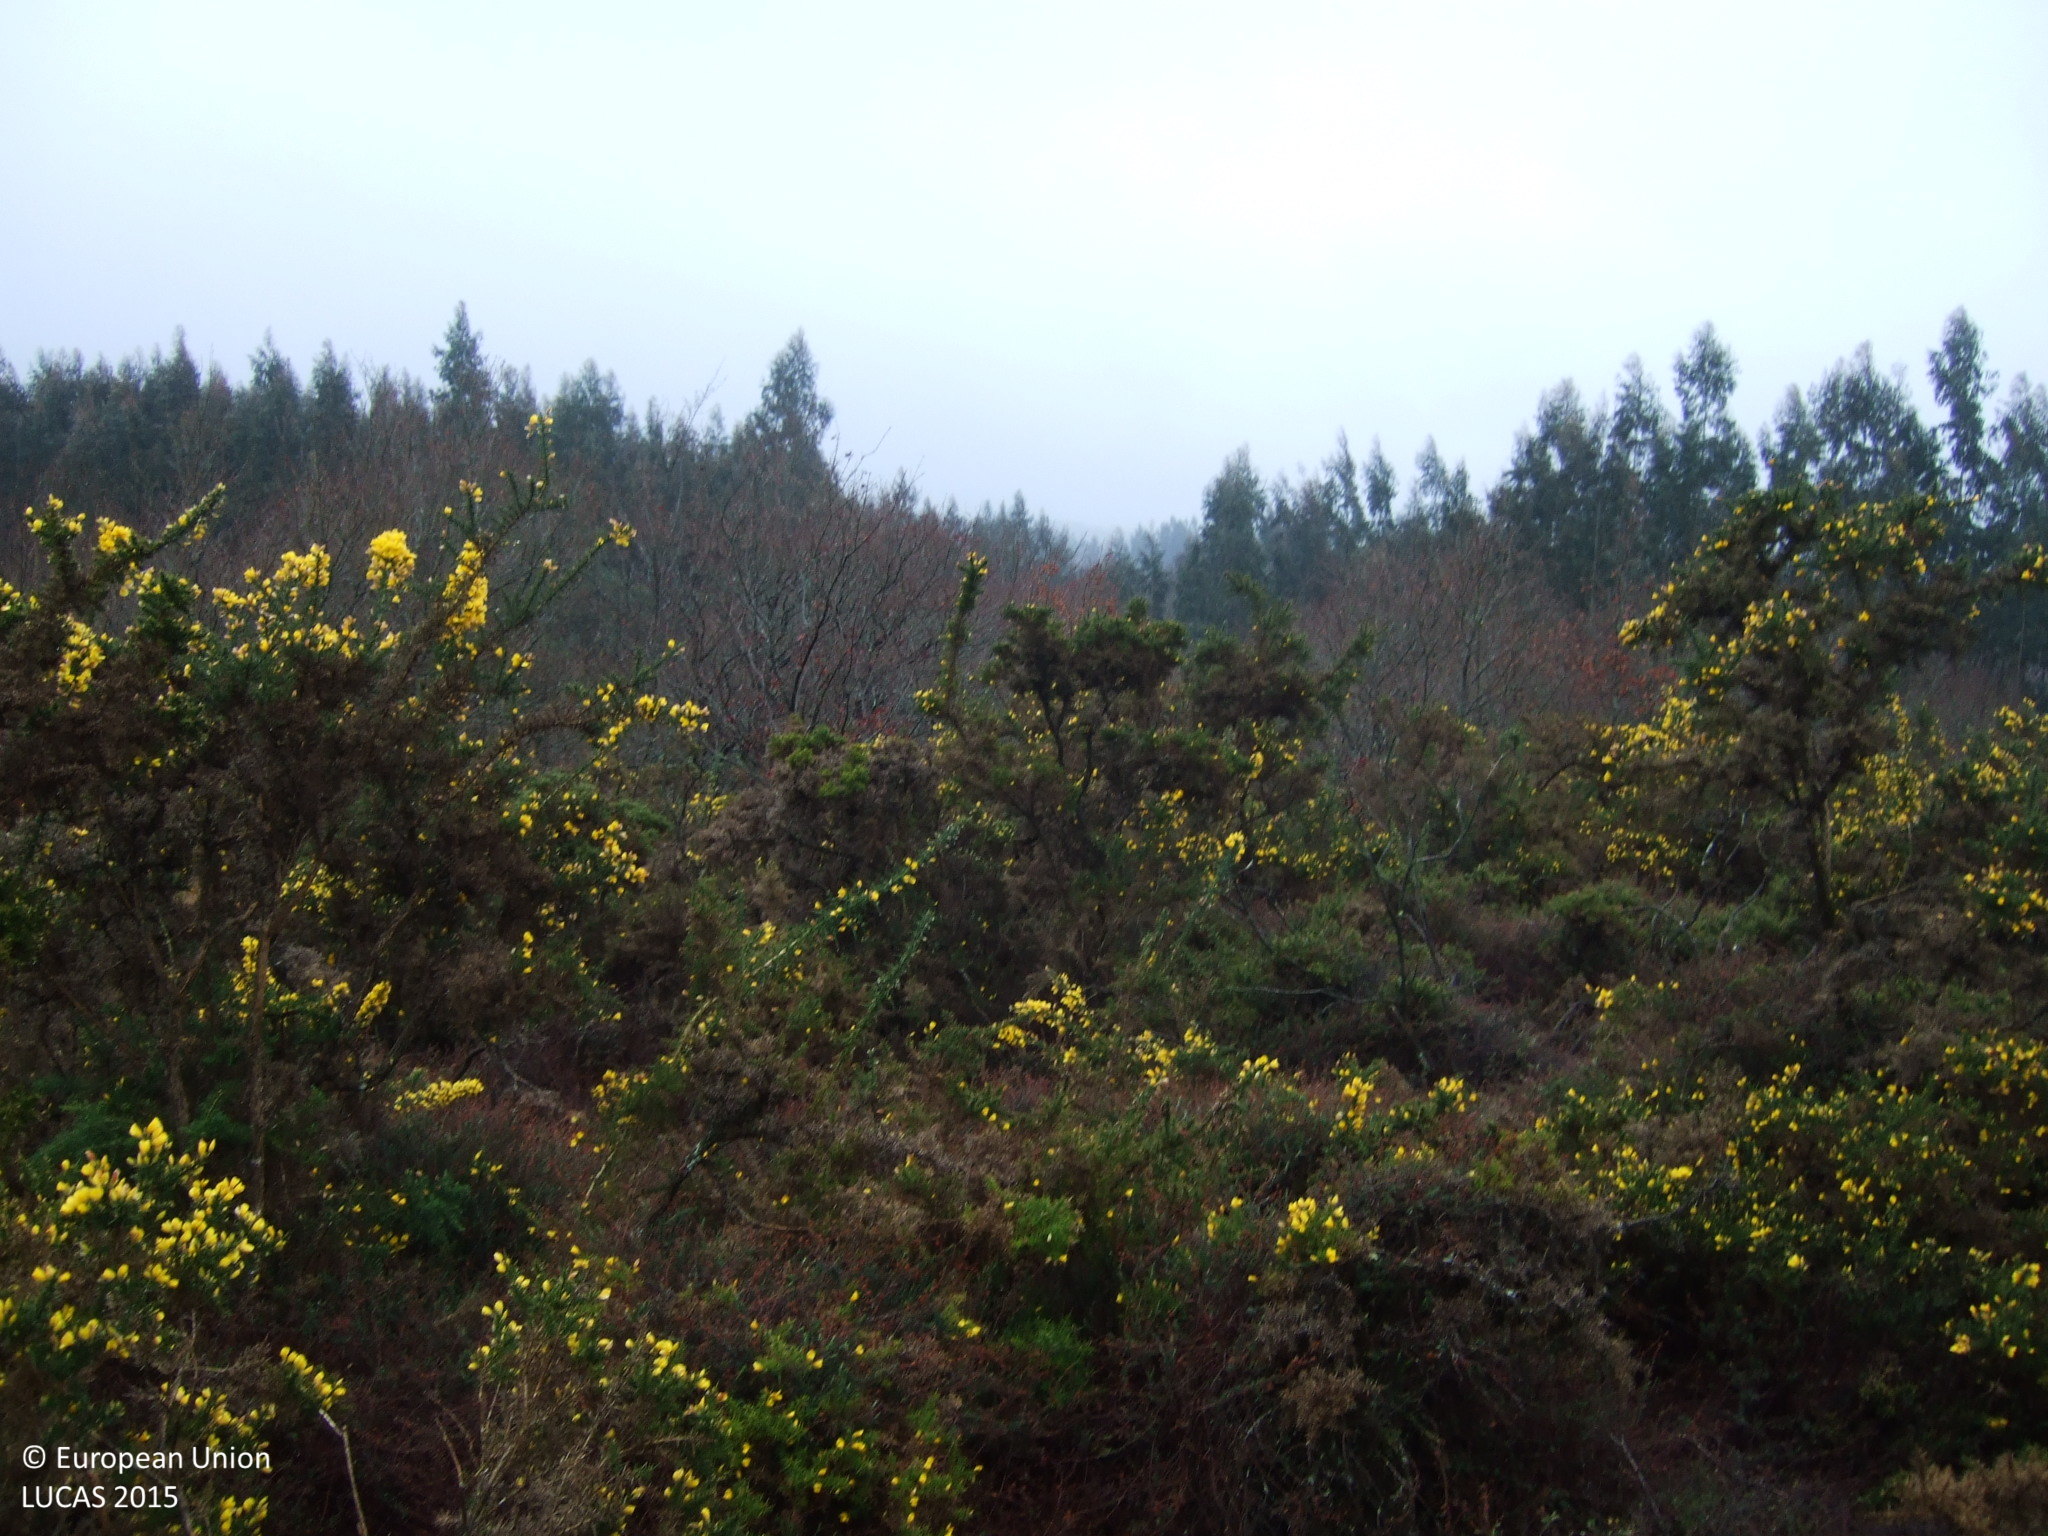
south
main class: Shrubland
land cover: Shrubland without tree cover
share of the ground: > 75 %
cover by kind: shrubs 100 %
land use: Semi-natural and natural areas not in use
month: March
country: ES
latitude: 42.8624
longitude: -7.8429
